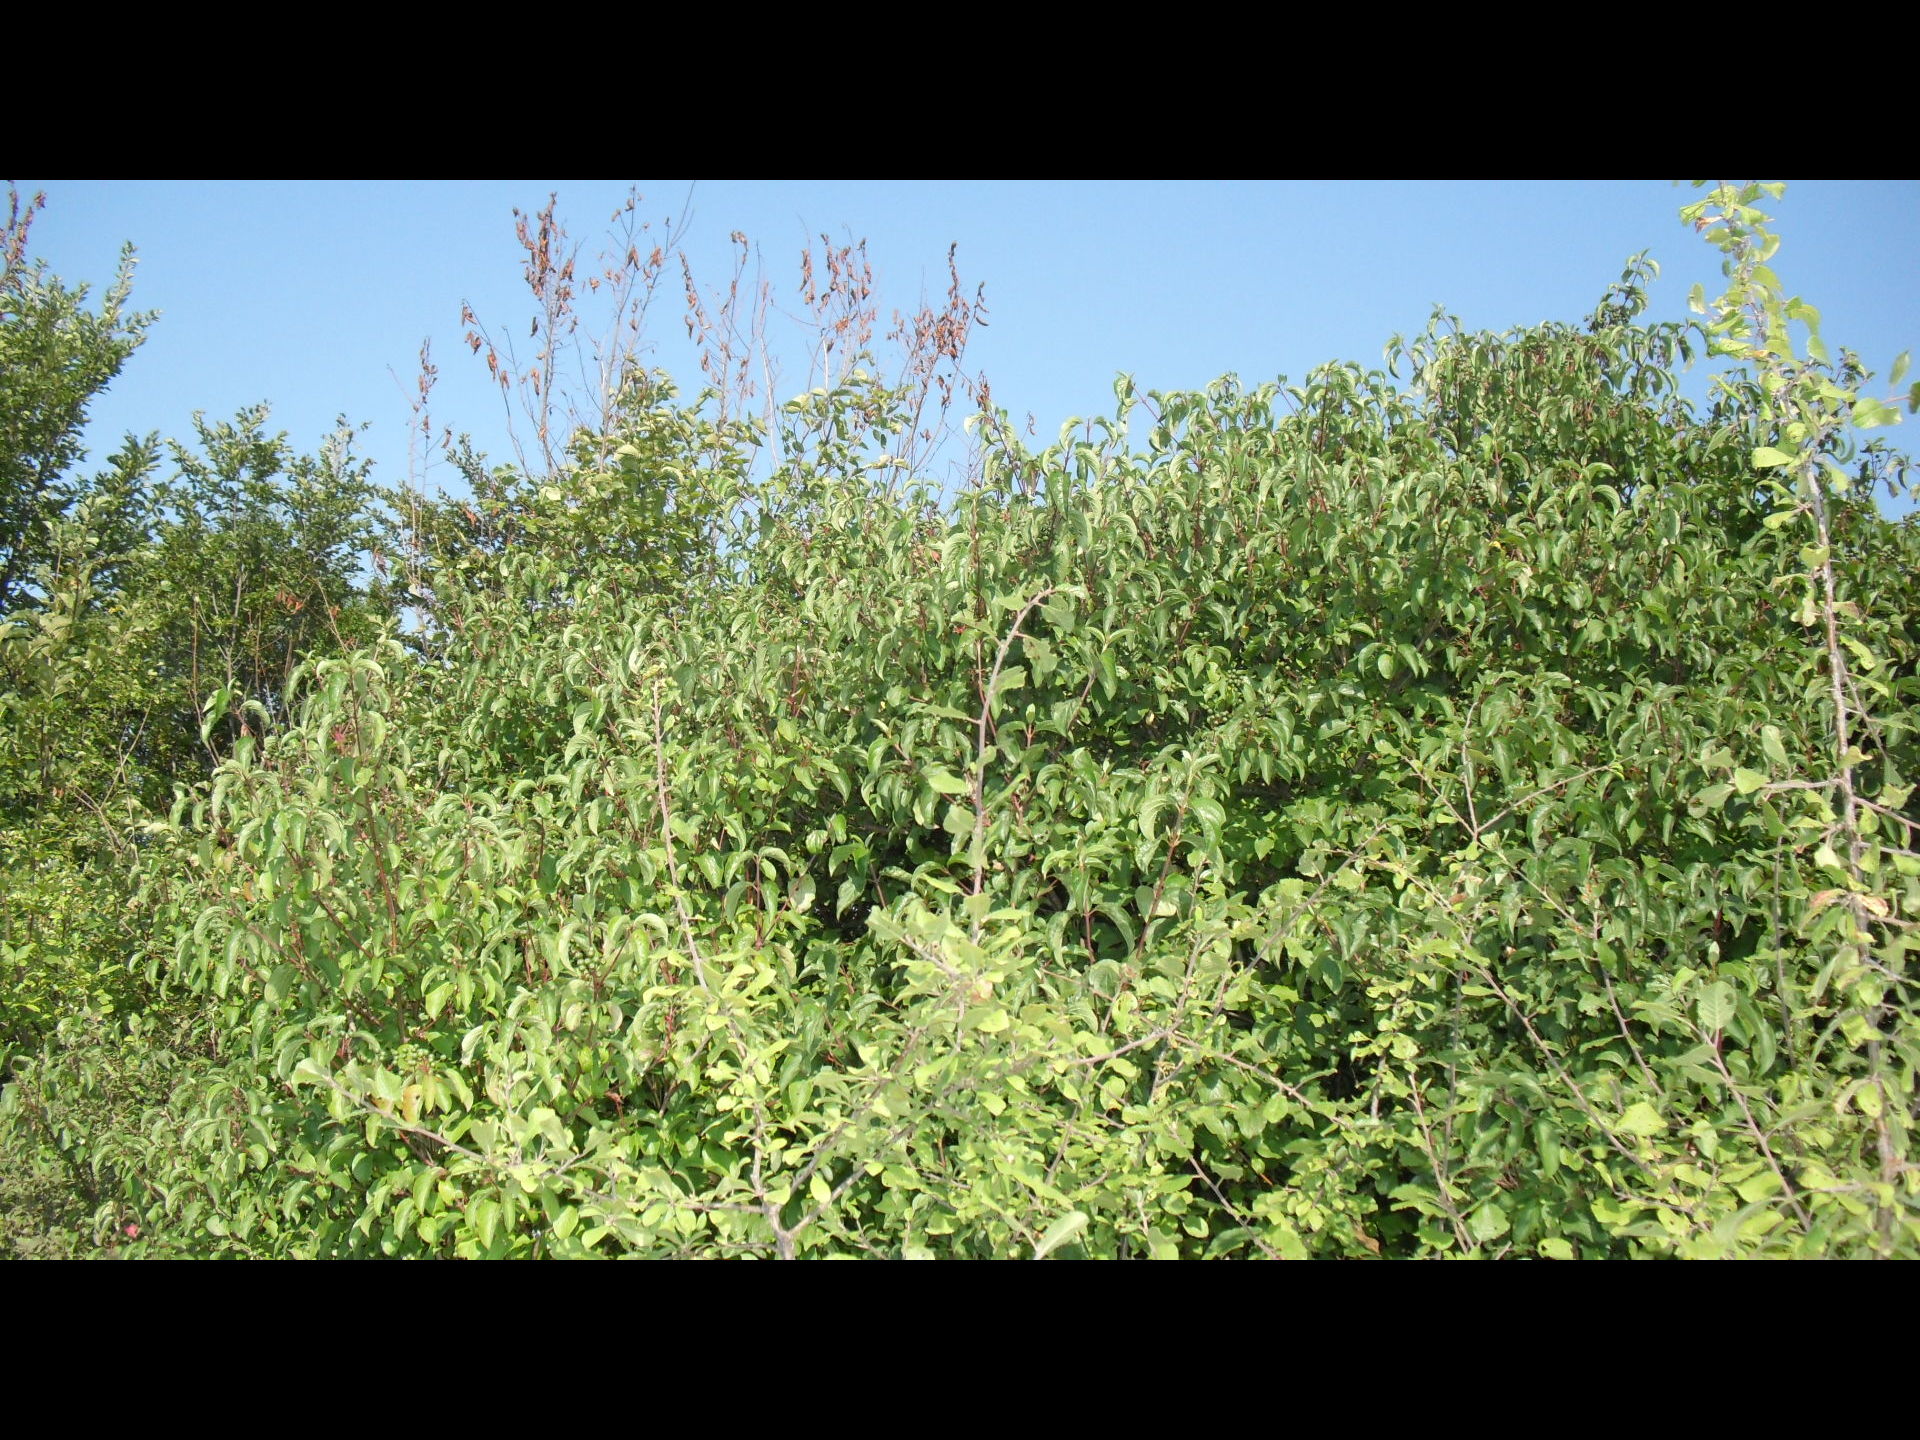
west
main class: Shrubland
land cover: Shrubland without tree cover
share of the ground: > 75 %
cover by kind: shrubs 85 %, herbaceous plants 15 %
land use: Semi-natural and natural areas not in use
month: July
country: BG
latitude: 43.7875
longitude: 22.9754
